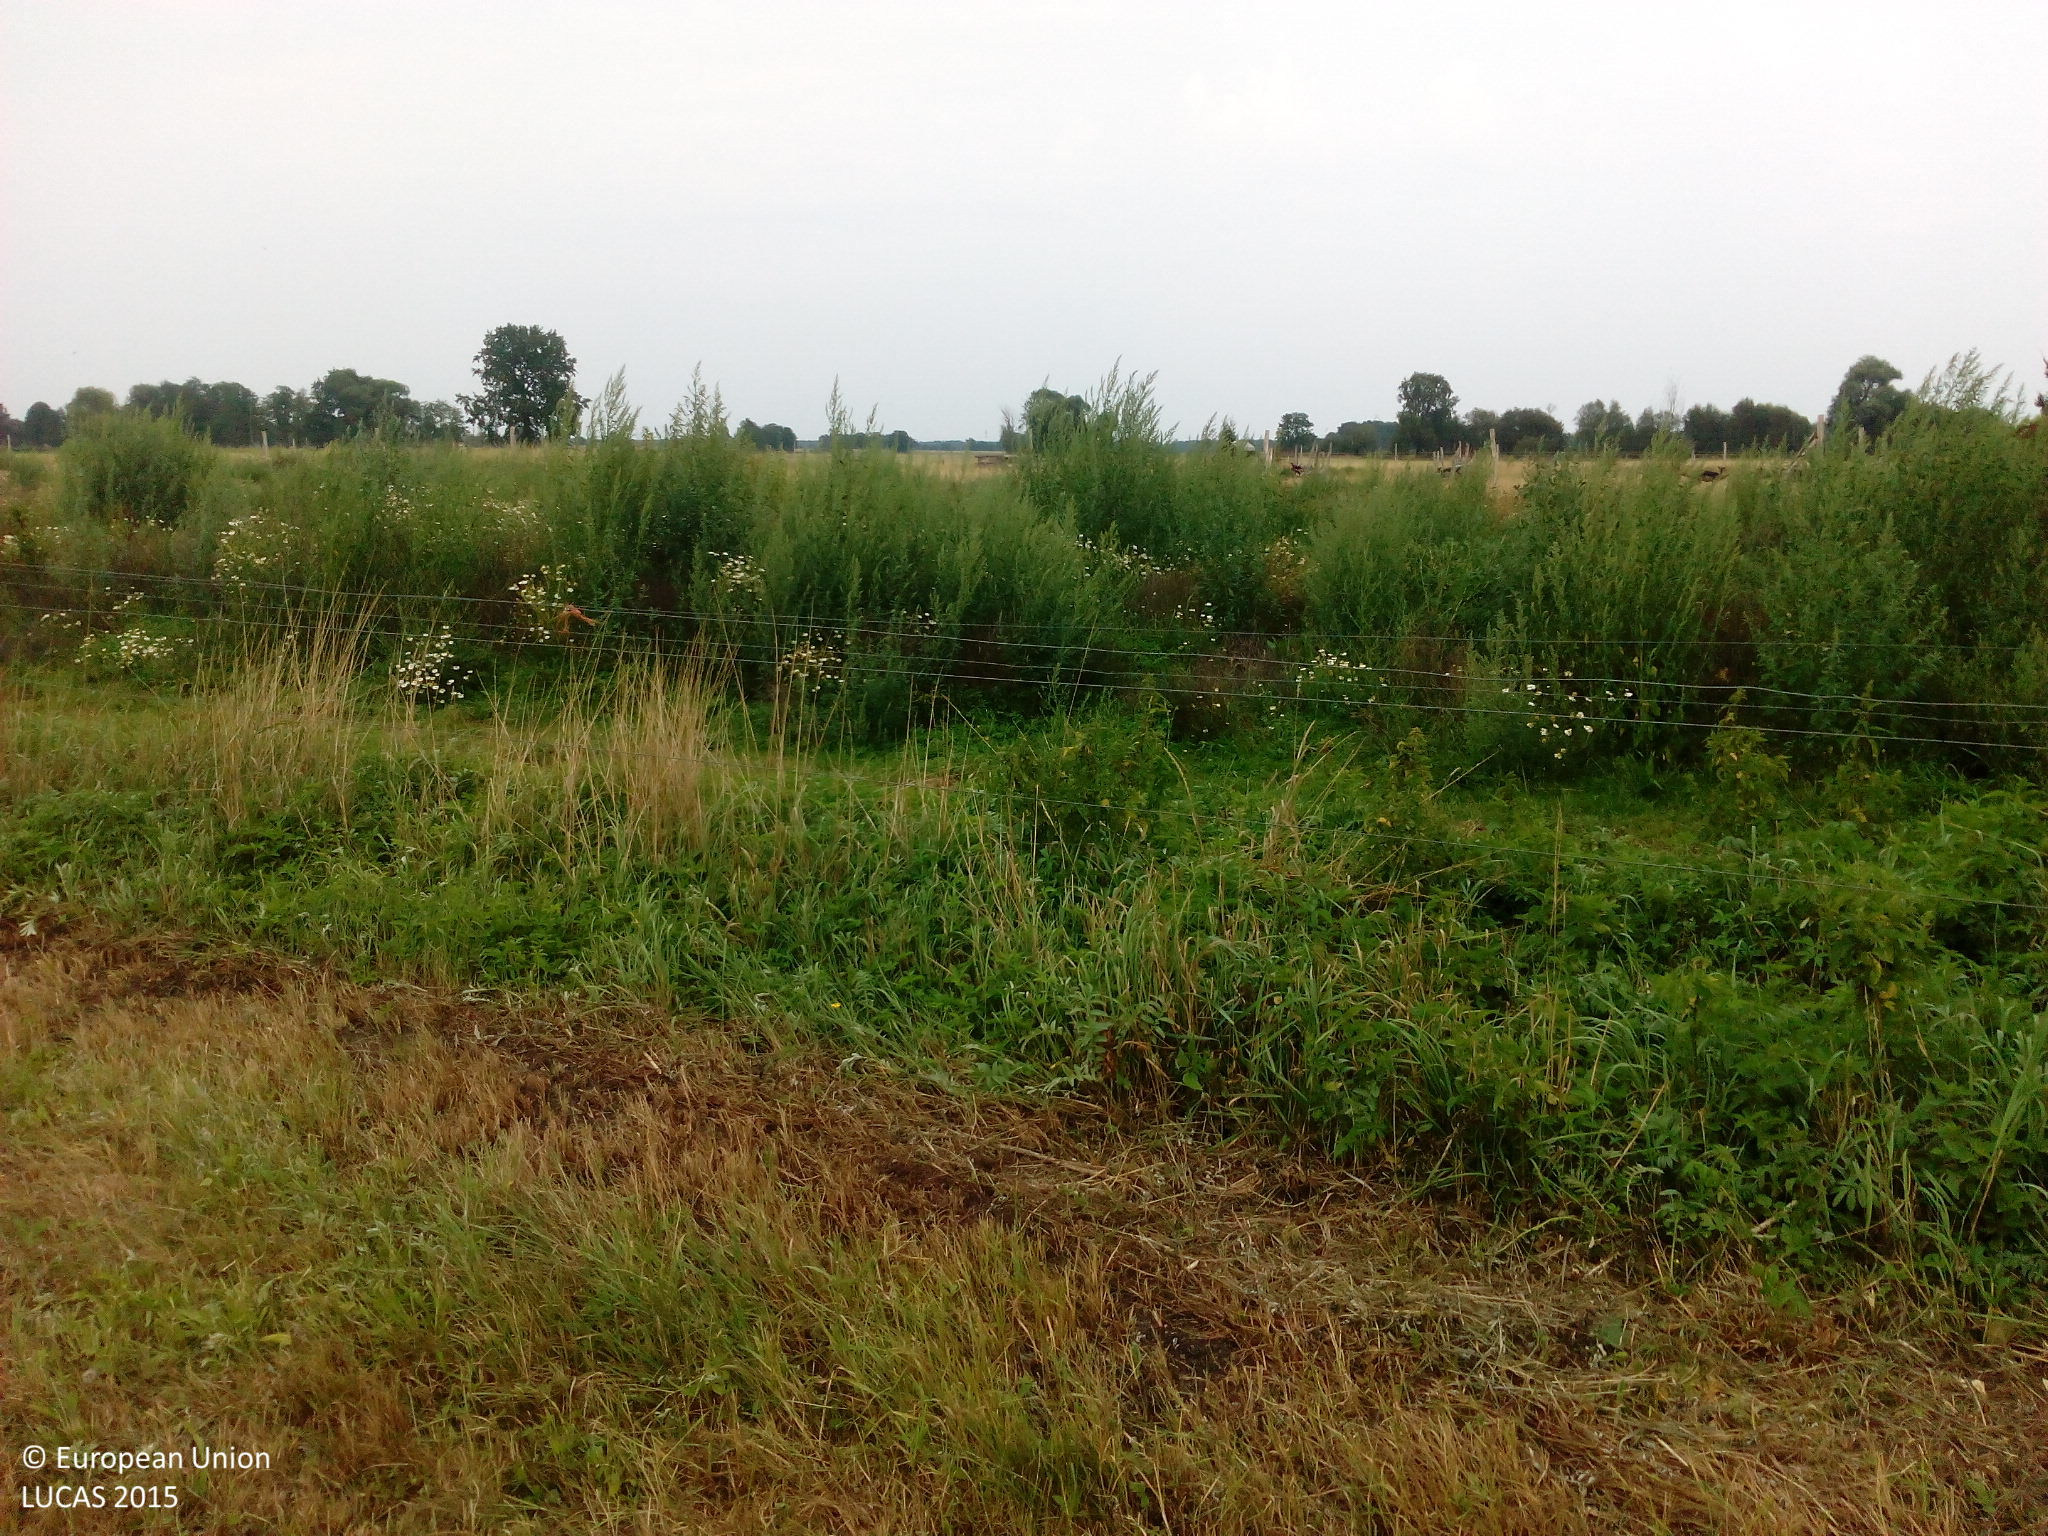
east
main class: Grassland
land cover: Grassland without tree/shrub cover
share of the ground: > 75 %
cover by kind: herbaceous plants 100 %
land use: Agriculture (excluding fallow land and kitchen gardens)
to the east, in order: Grassland without tree/shrub cover; Fences; Spontaneously vegetated surfaces; Fences; Grassland without tree/shrub cover; Fences; Grassland without tree/shrub cover; Fences; Grassland without tree/shrub cover
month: August
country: DE
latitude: 51.8141
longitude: 13.1478
